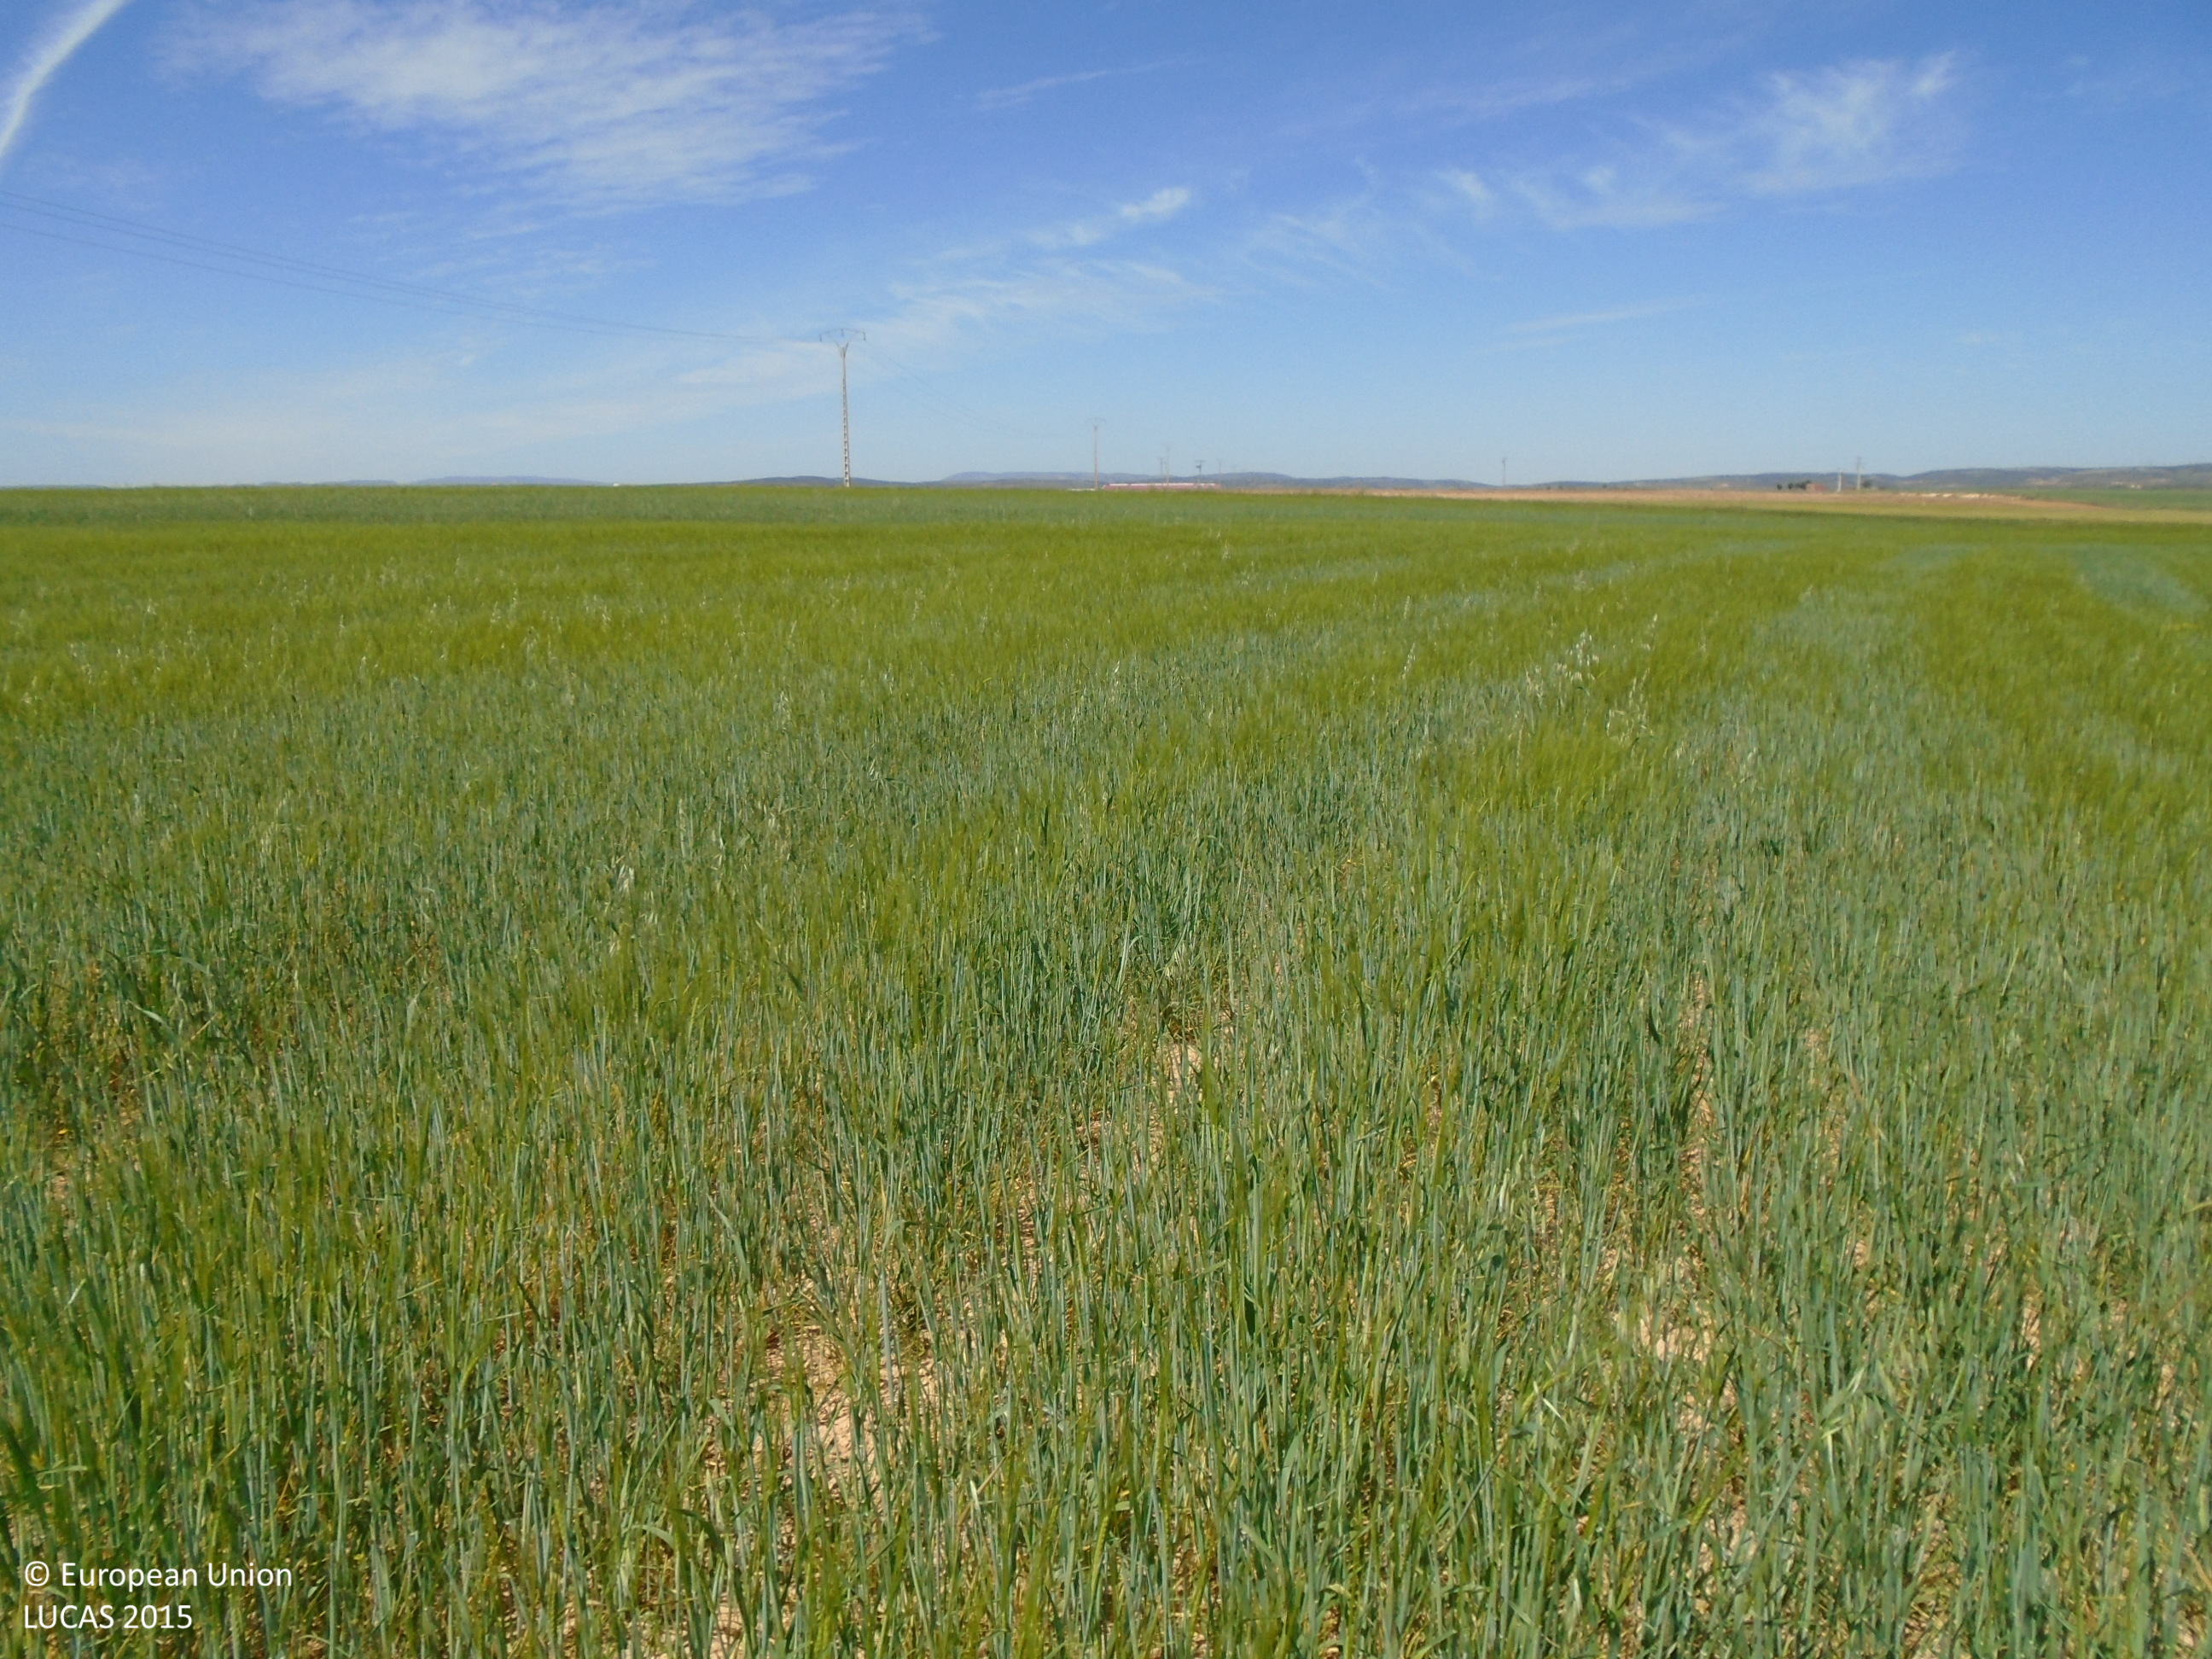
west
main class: Cropland
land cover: Barley
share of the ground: > 75 %
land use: Agriculture (excluding fallow land and kitchen gardens)
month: May
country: ES
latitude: 39.6029
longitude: -3.6401
